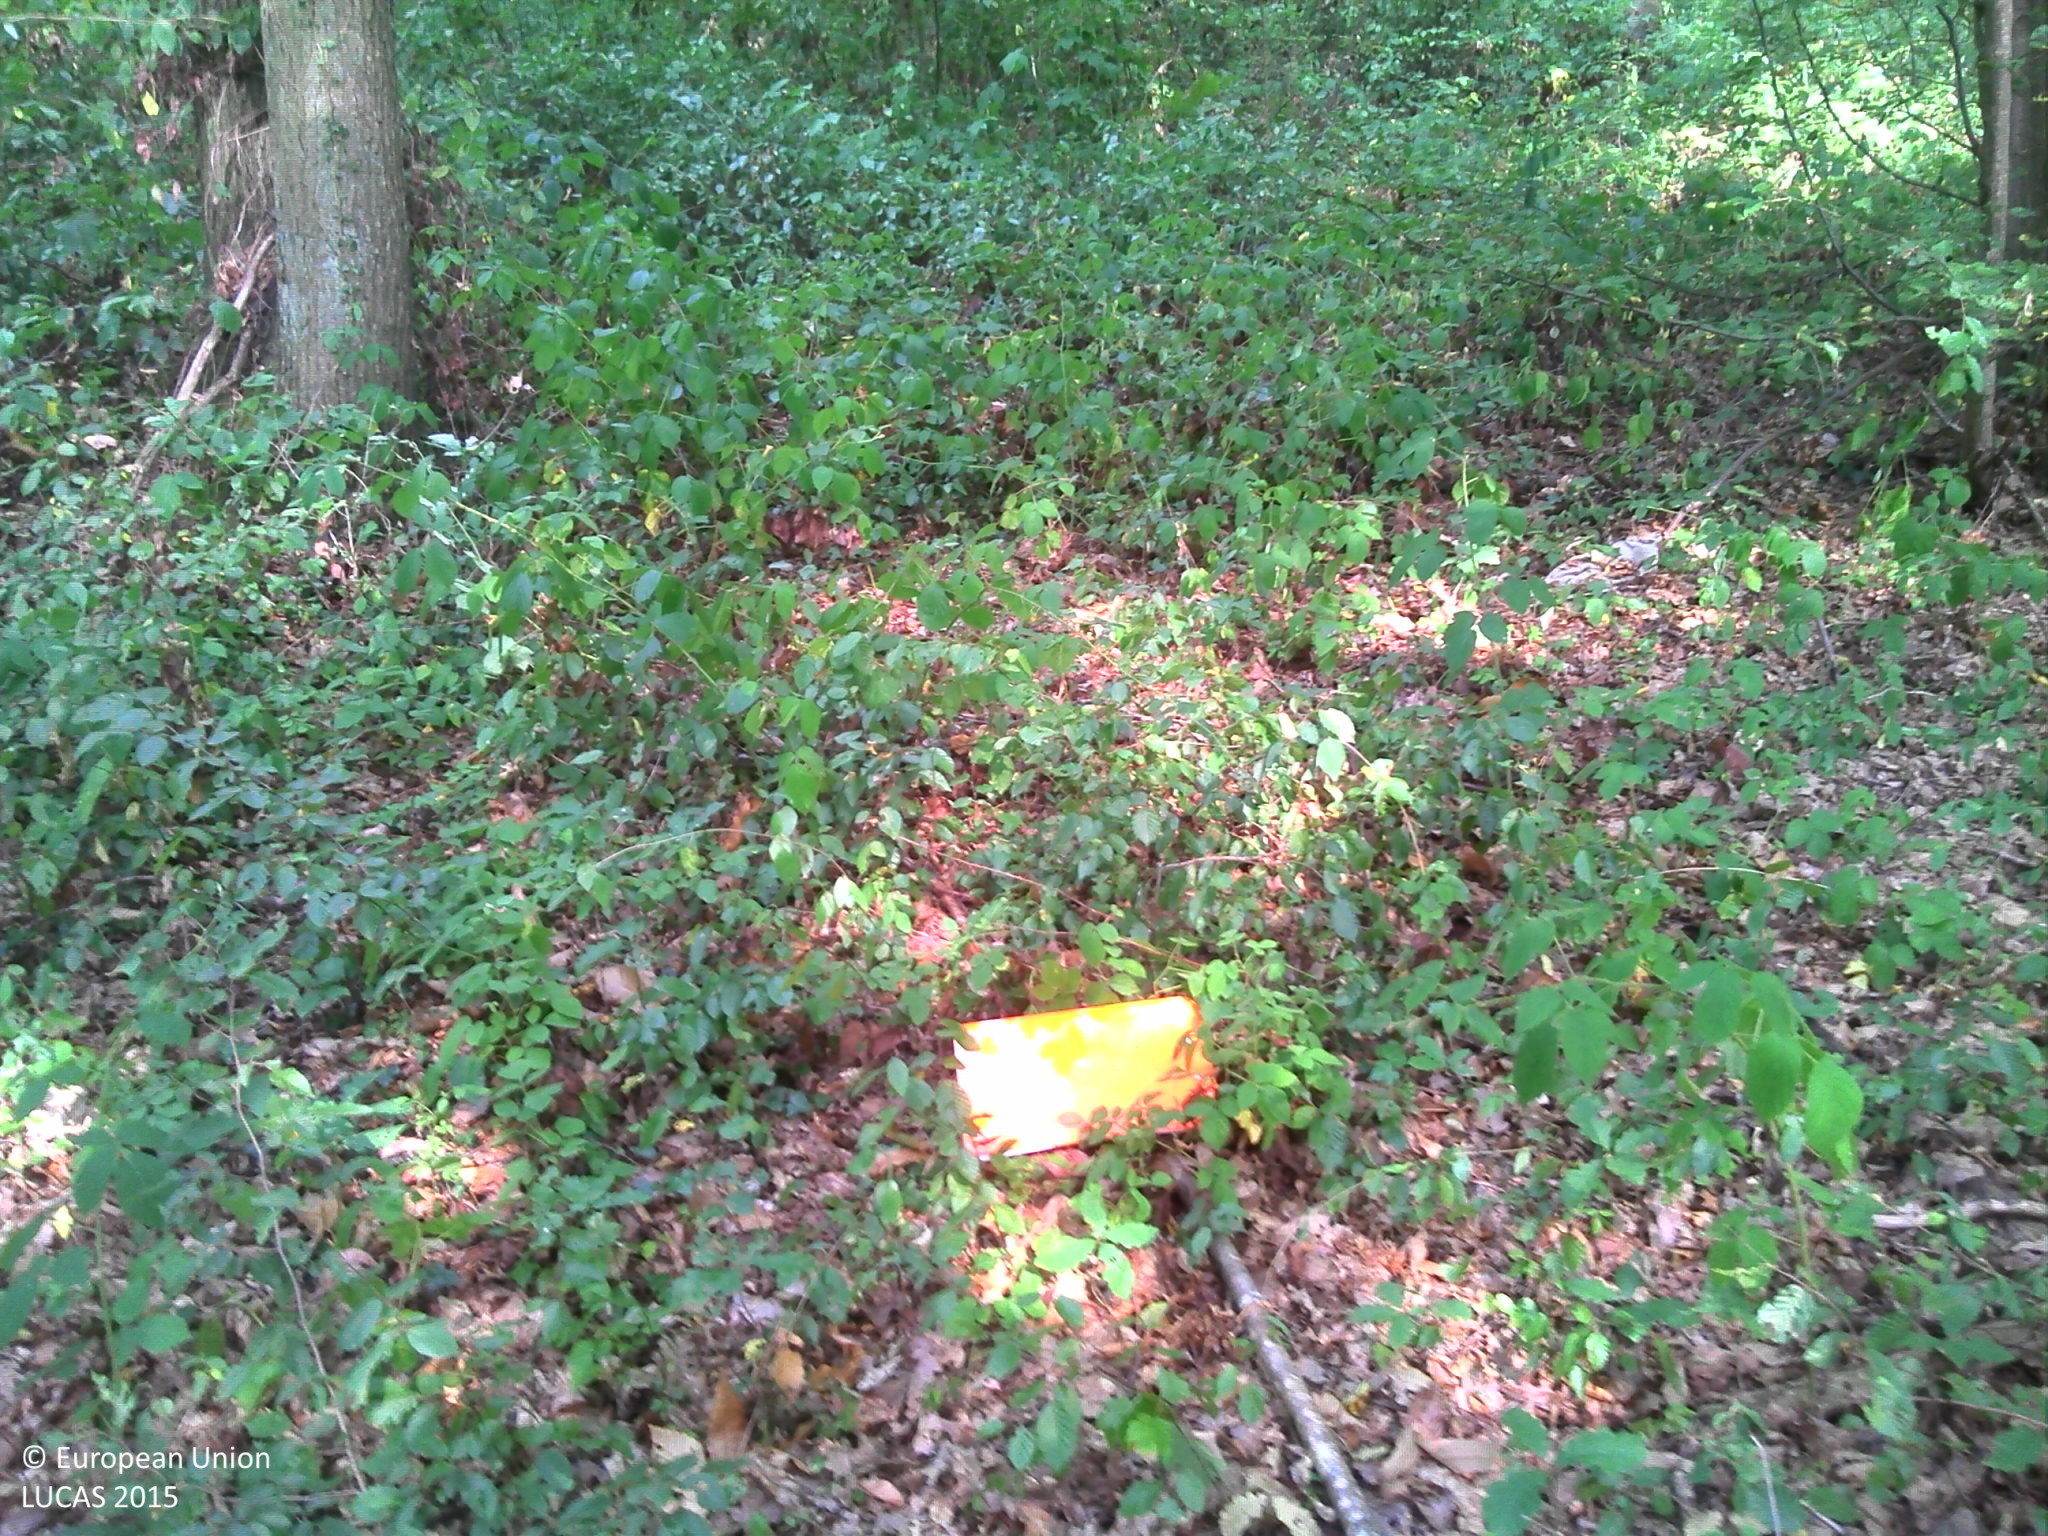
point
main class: Woodland
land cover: Broadleaved woodland
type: acidophilous oak and oak-birch forest
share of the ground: > 75 %
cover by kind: broadleaved forest trees 60 %, herbaceous plants 15 %, lichens and mosses 15 %, unconsolidated bare surface 10 %
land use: Forestry
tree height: > 5 m
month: August
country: FR
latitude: 48.9182
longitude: 2.6614
